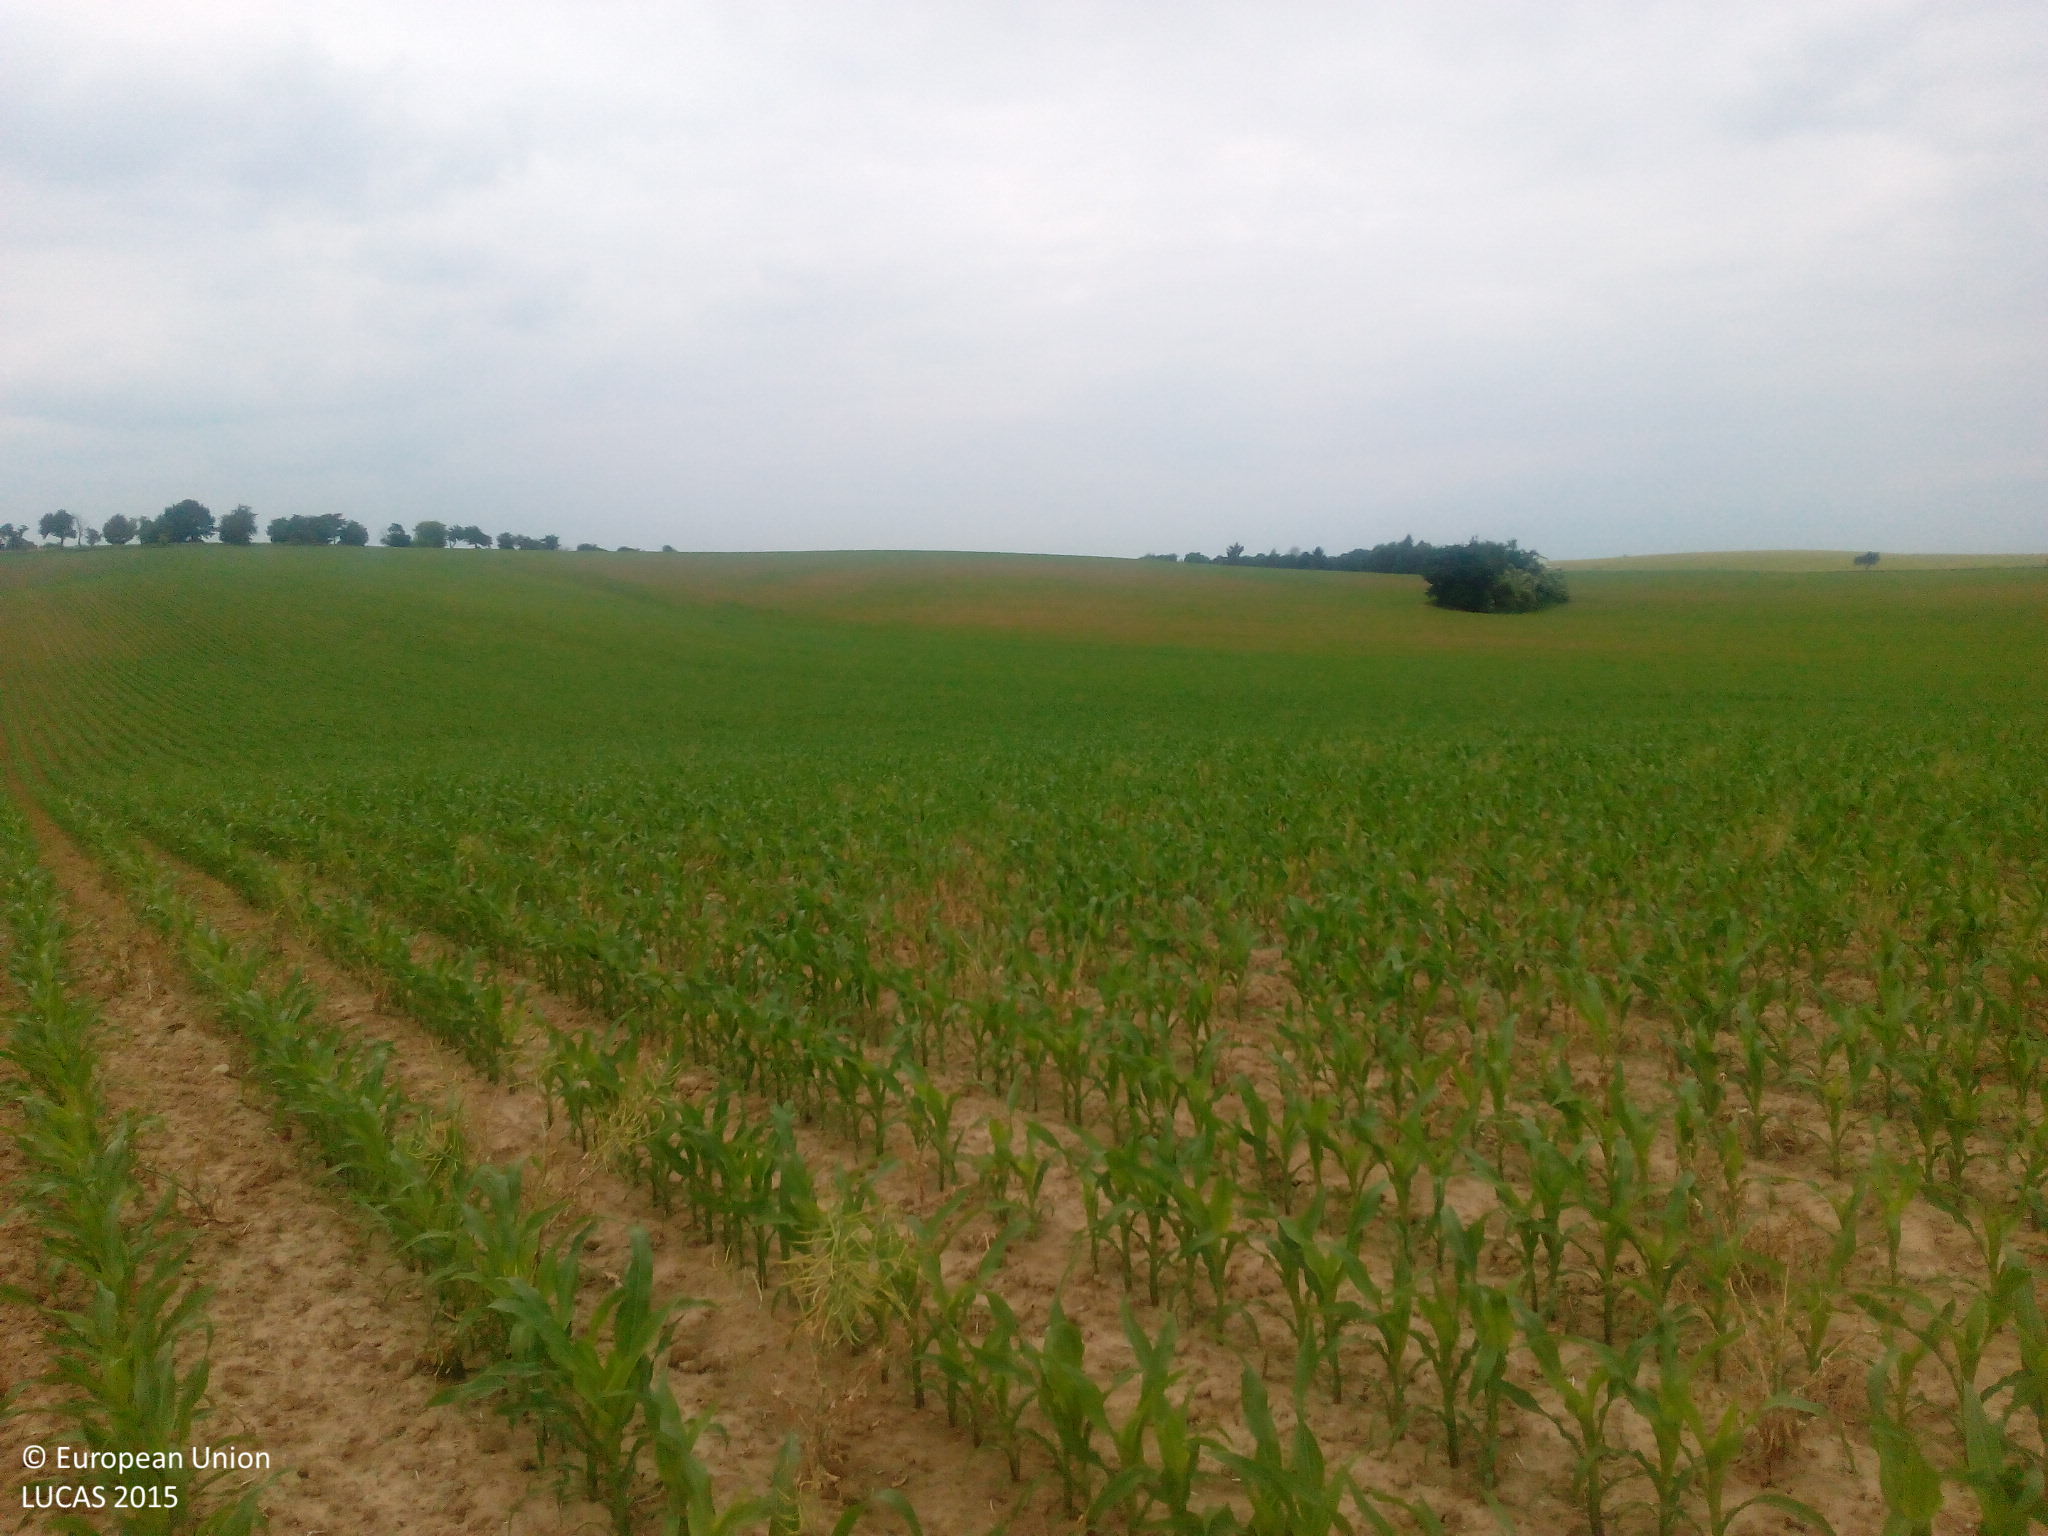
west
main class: Cropland
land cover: Maize
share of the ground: 25 - 50 %
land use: Agriculture (excluding fallow land and kitchen gardens)
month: June
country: DE
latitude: 51.2036
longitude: 13.1059
